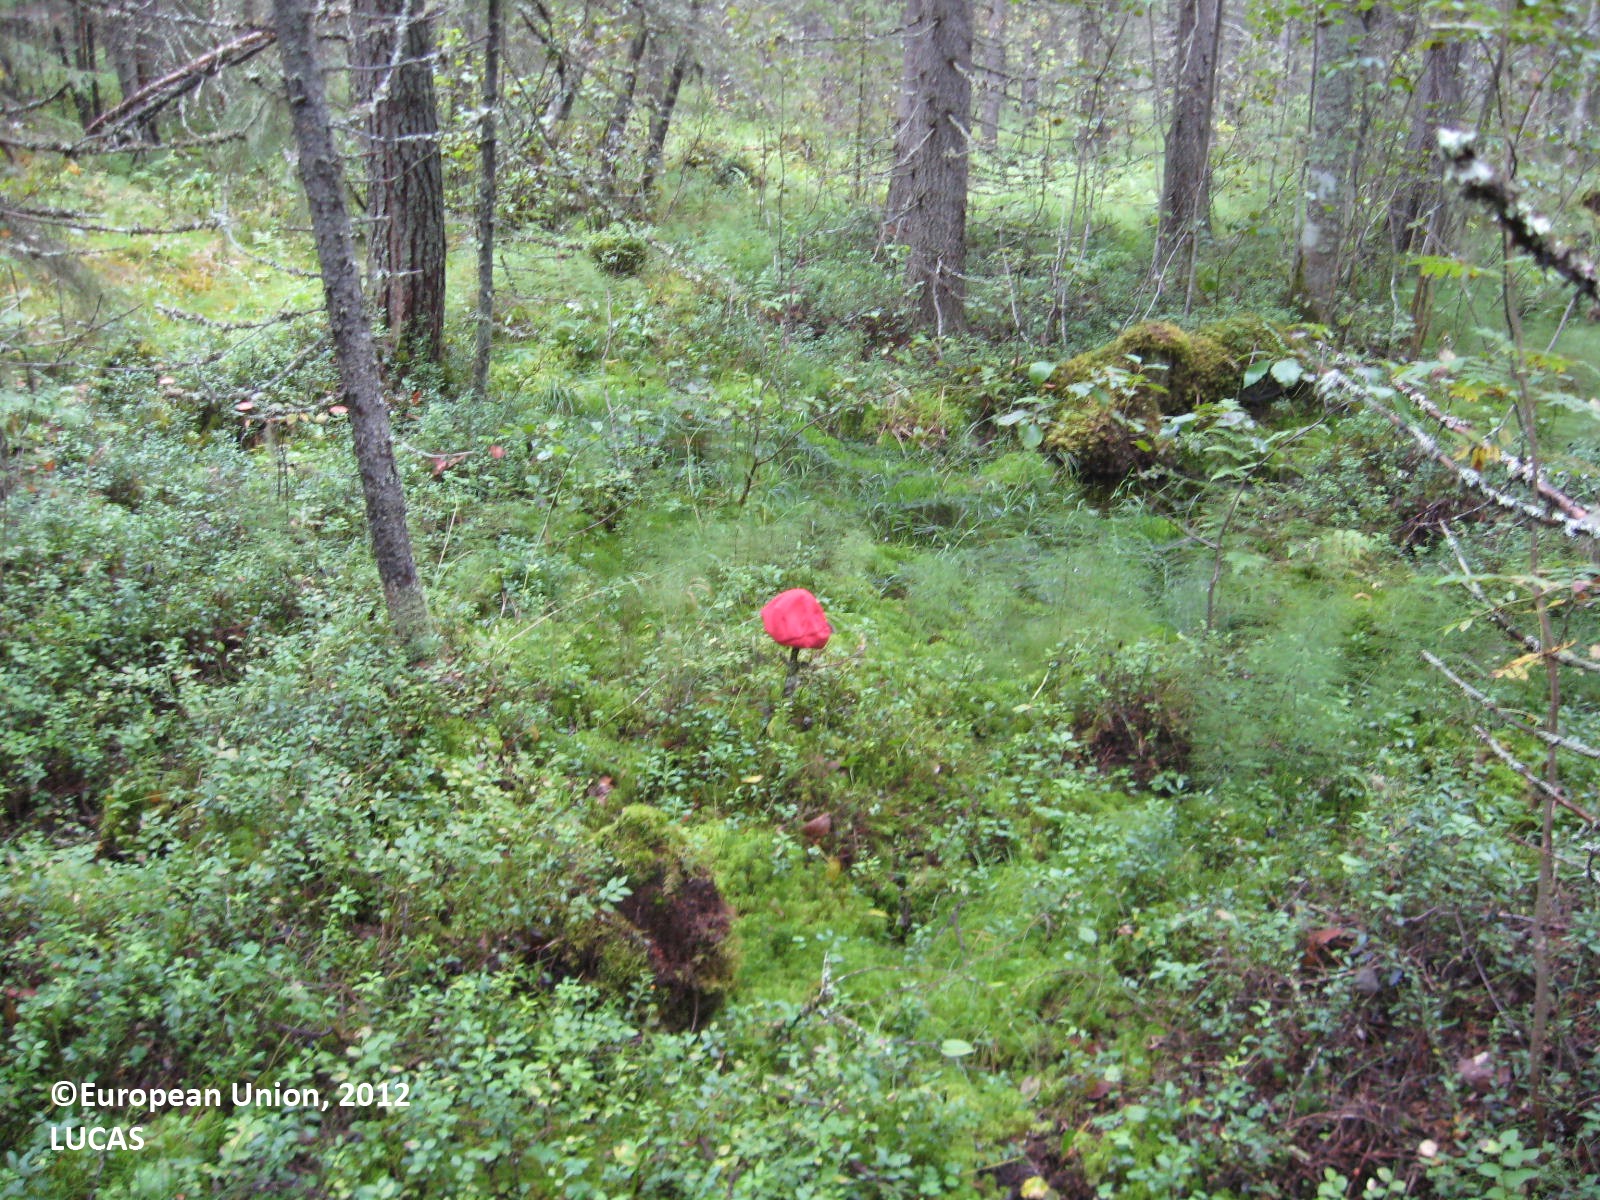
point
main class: Woodland
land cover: Spruce dominated coniferous woodland
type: boreal forest
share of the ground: > 75 %
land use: Forestry
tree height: > 5 m
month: August
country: FI
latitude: 63.4833
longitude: 29.5214
